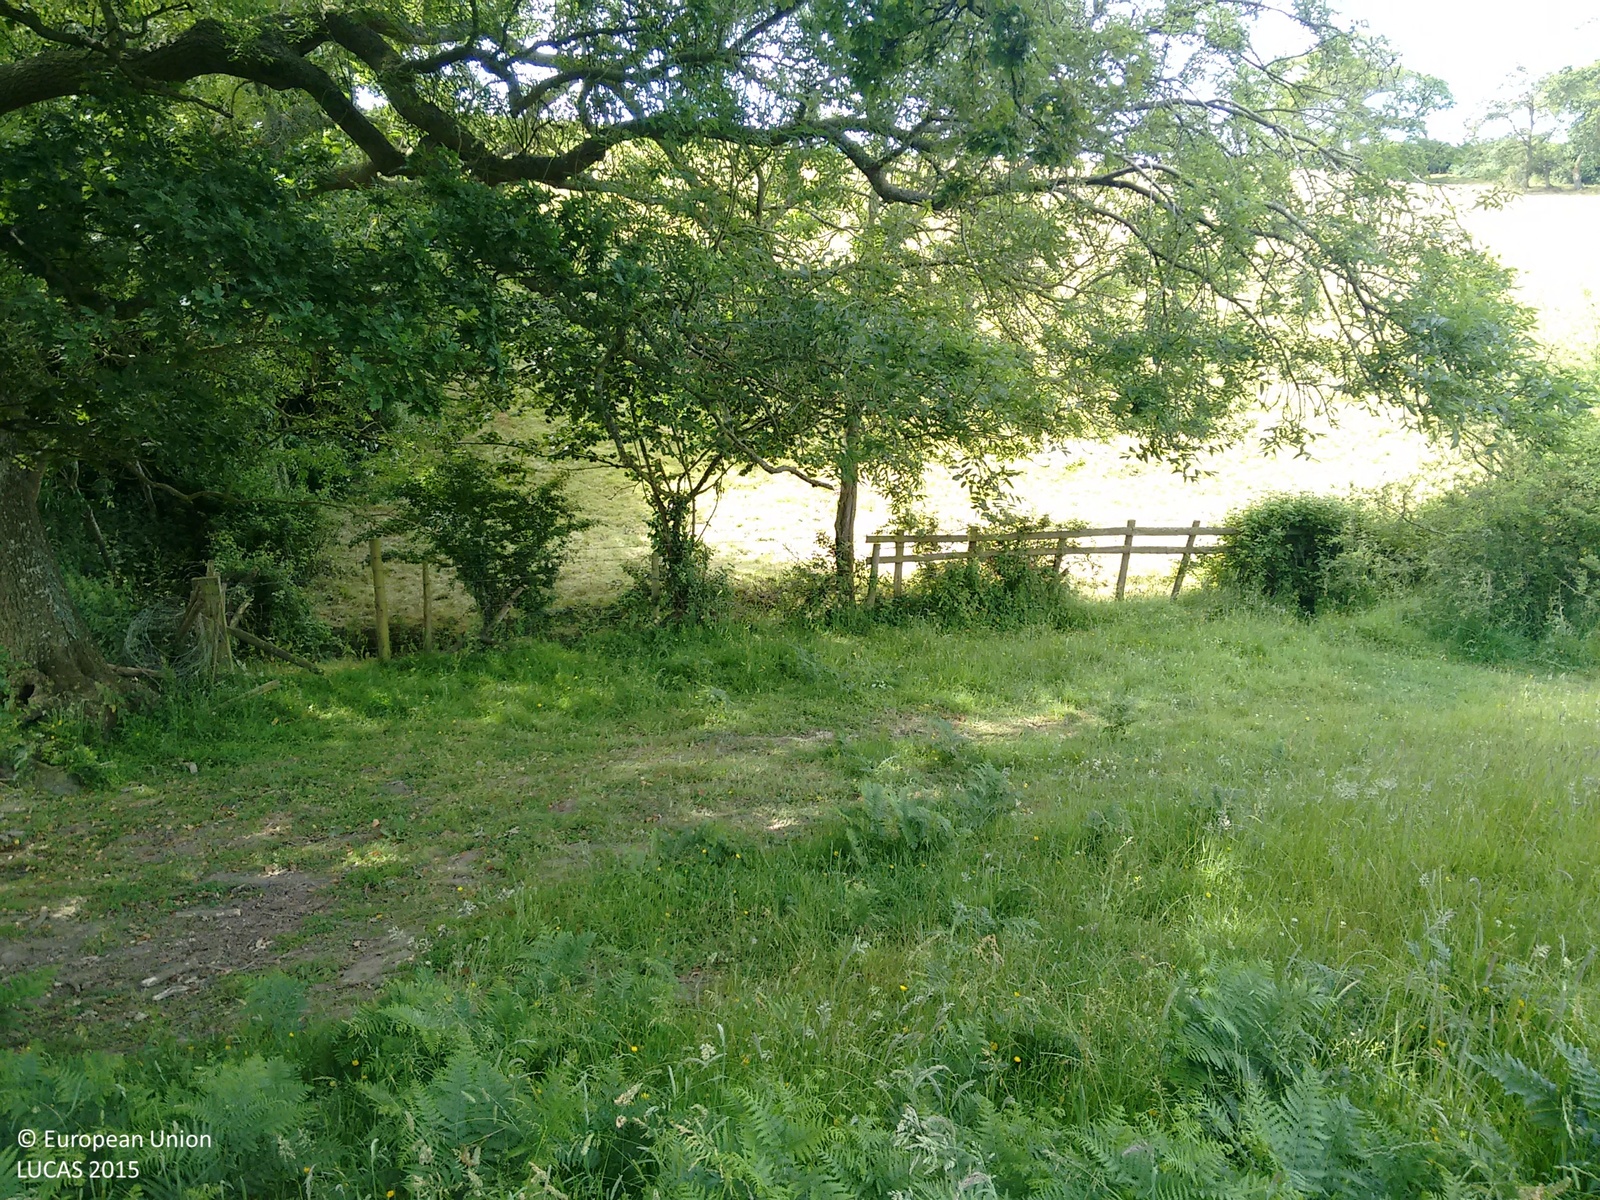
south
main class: Grassland
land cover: Grassland with sparse tree/shrub cover
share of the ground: > 75 %
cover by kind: herbaceous plants 85 %, shrubs 10 %, broadleaved forest trees 5 %
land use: Agriculture (excluding fallow land and kitchen gardens)
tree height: > 5 m
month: June
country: GB
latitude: 50.8633
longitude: 0.3808
